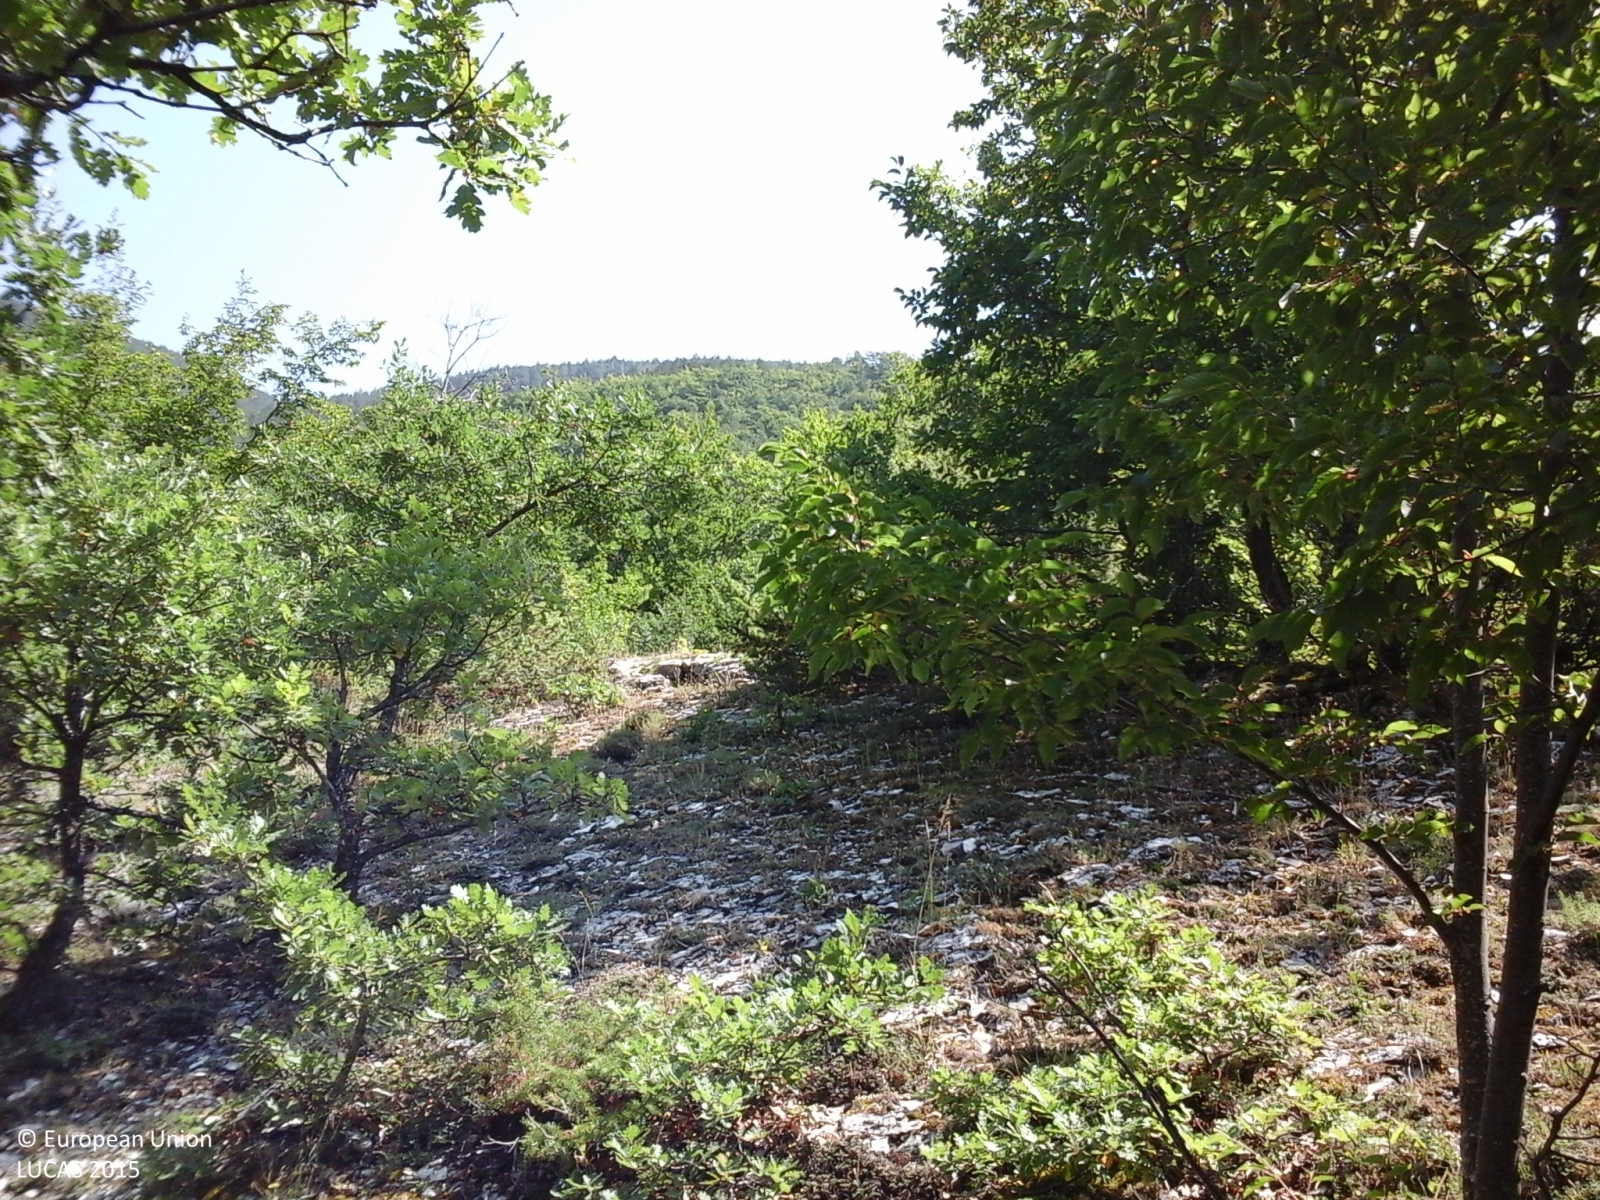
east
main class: Woodland
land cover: Broadleaved woodland
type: thermophilous deciduous forest
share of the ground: > 75 %
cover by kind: broadleaved forest trees 100 %
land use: Forestry
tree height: < 5 m
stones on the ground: > 50 %
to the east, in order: Broadleaved woodland
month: August
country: IT
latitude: 42.9667
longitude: 13.1419
